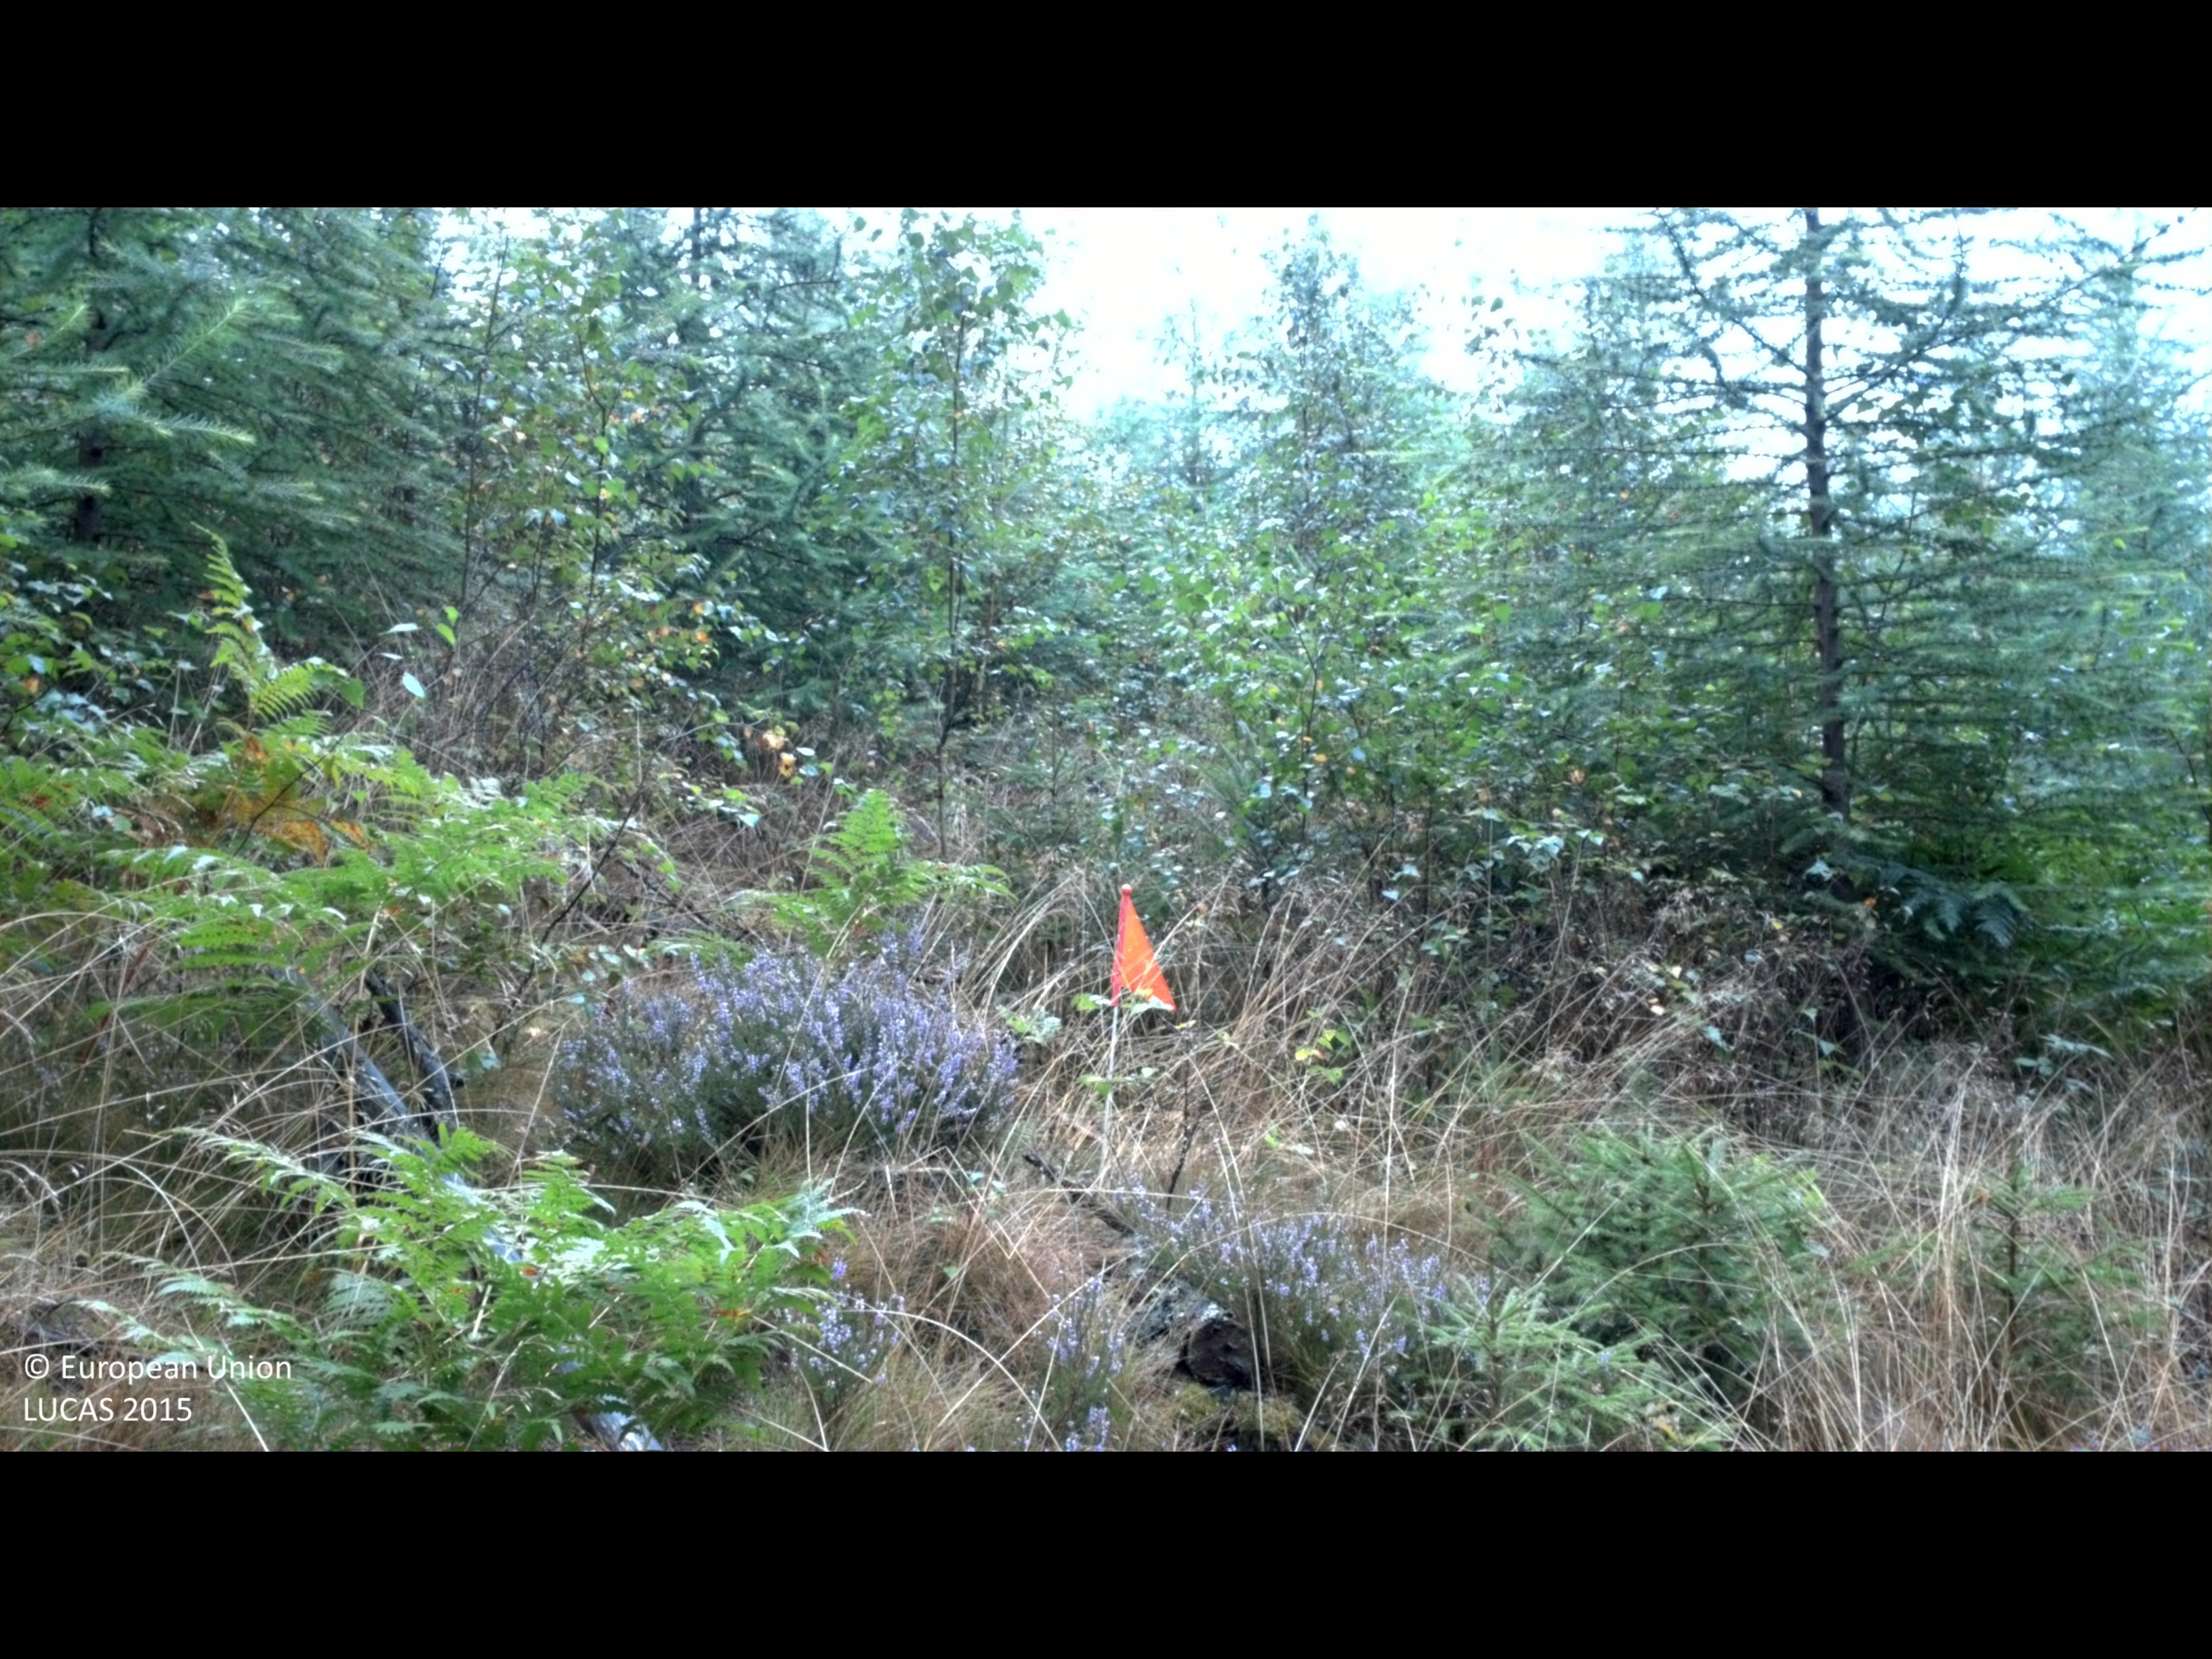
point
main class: Woodland
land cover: Other mixed woodland
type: boreal forest
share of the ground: 50 - 75 %
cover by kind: coniferous forest trees 35 %, broadleaved forest trees 35 %, shrubs 15 %, herbaceous plants 15 %
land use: Forestry
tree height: < 5 m
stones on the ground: 10 - 25 %
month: August
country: SE
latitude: 57.3366
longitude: 13.8334
